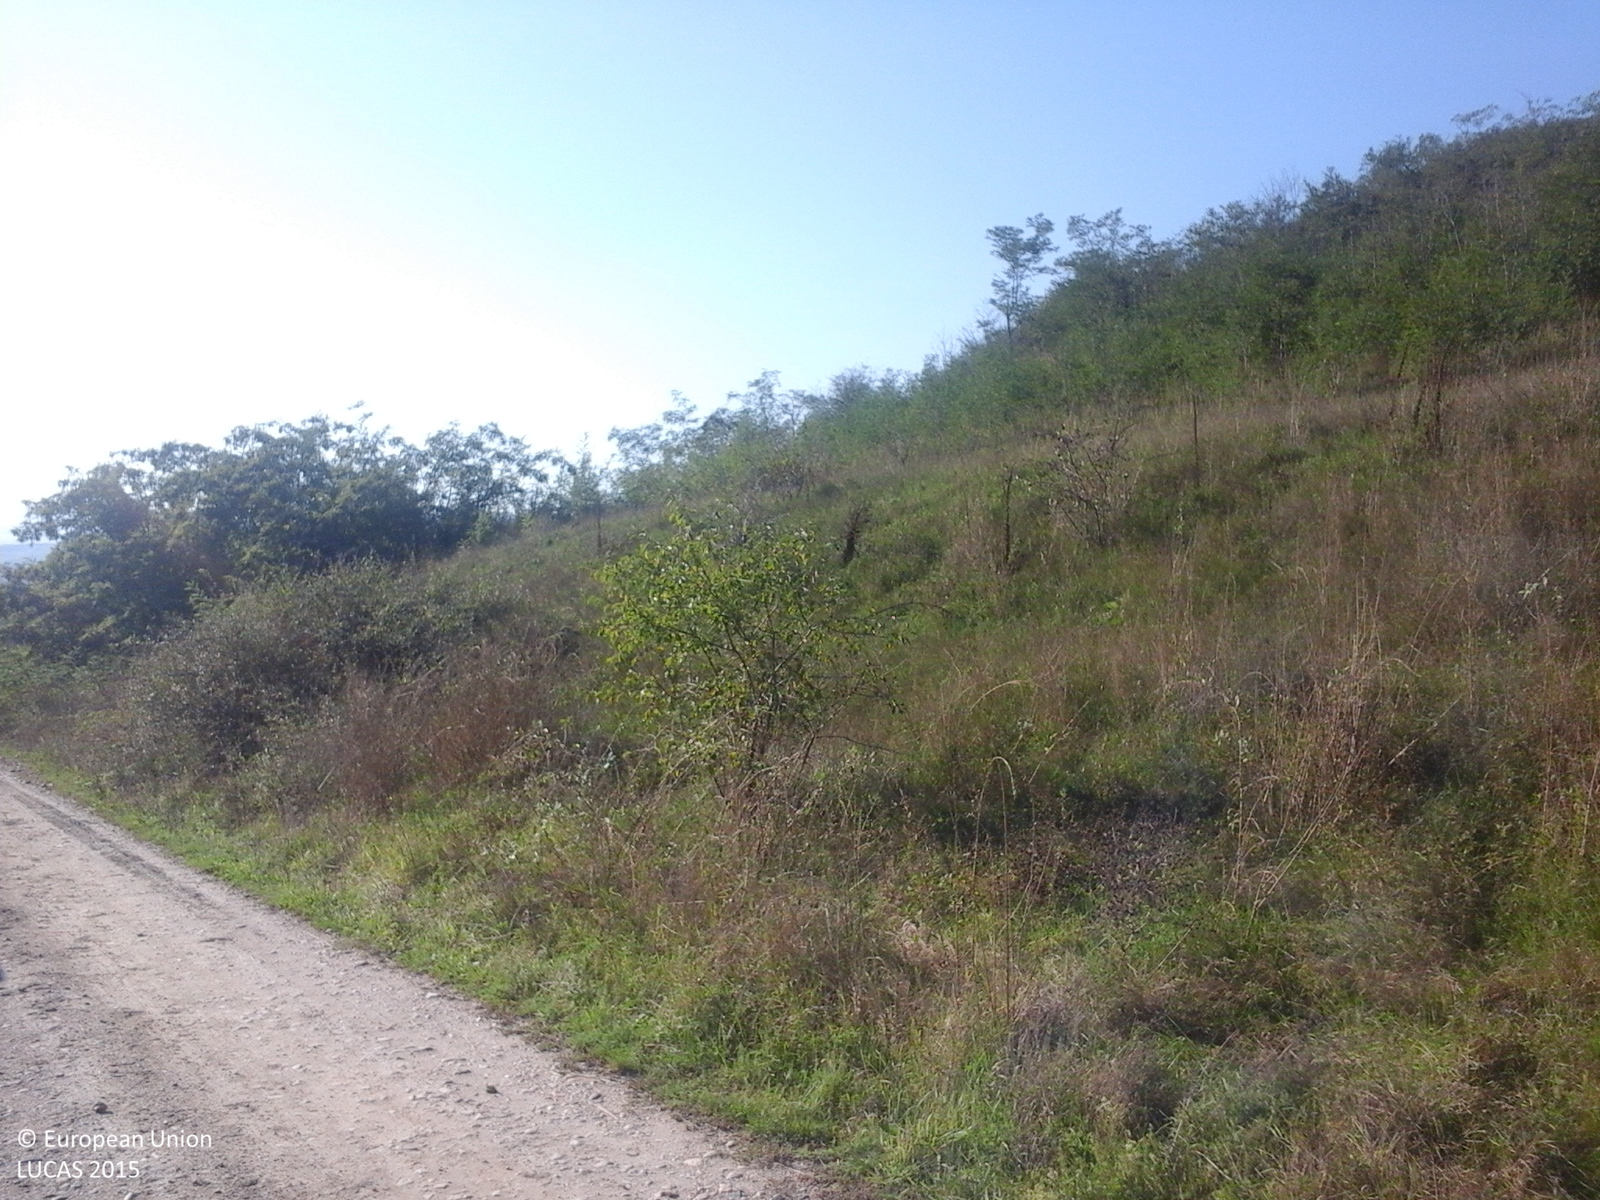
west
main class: Grassland
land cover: Grassland without tree/shrub cover
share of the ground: > 75 %
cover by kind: herbaceous plants 100 %
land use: Agriculture (excluding fallow land and kitchen gardens)
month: October
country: RO
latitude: 46.3665
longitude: 23.7854
